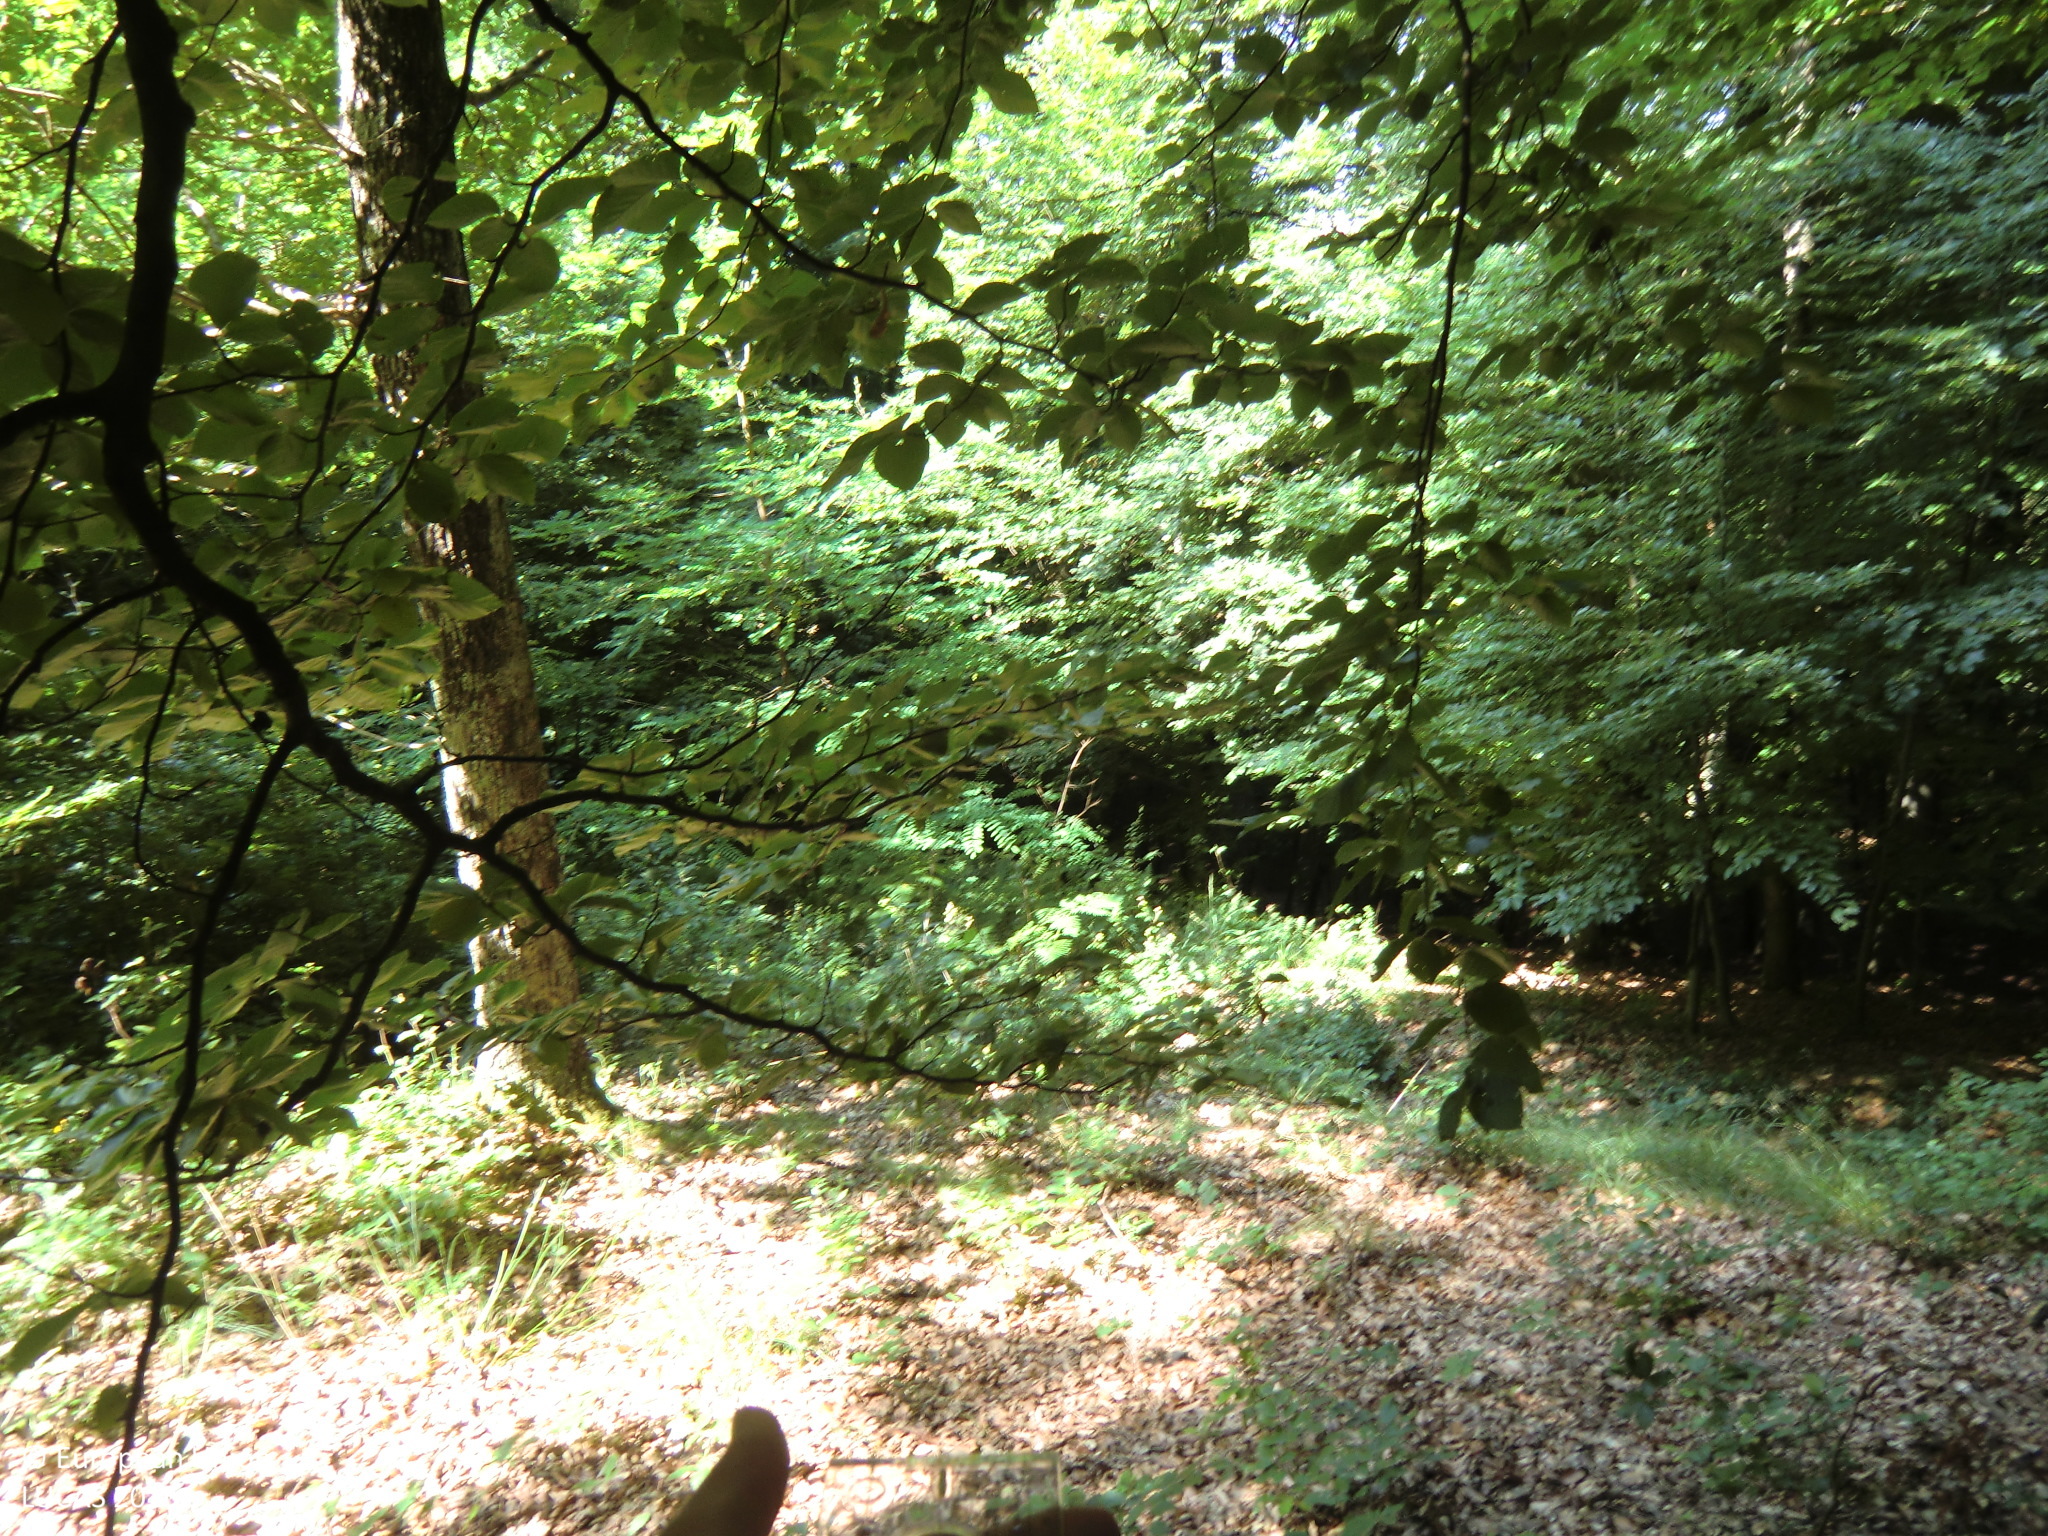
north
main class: Woodland
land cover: Broadleaved woodland
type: beech forest
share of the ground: > 75 %
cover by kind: broadleaved forest trees 80 %, herbaceous plants 10 %, unconsolidated bare surface 10 %
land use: Forestry
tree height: > 5 m
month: July
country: AT
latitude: 47.0142
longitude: 16.3030
